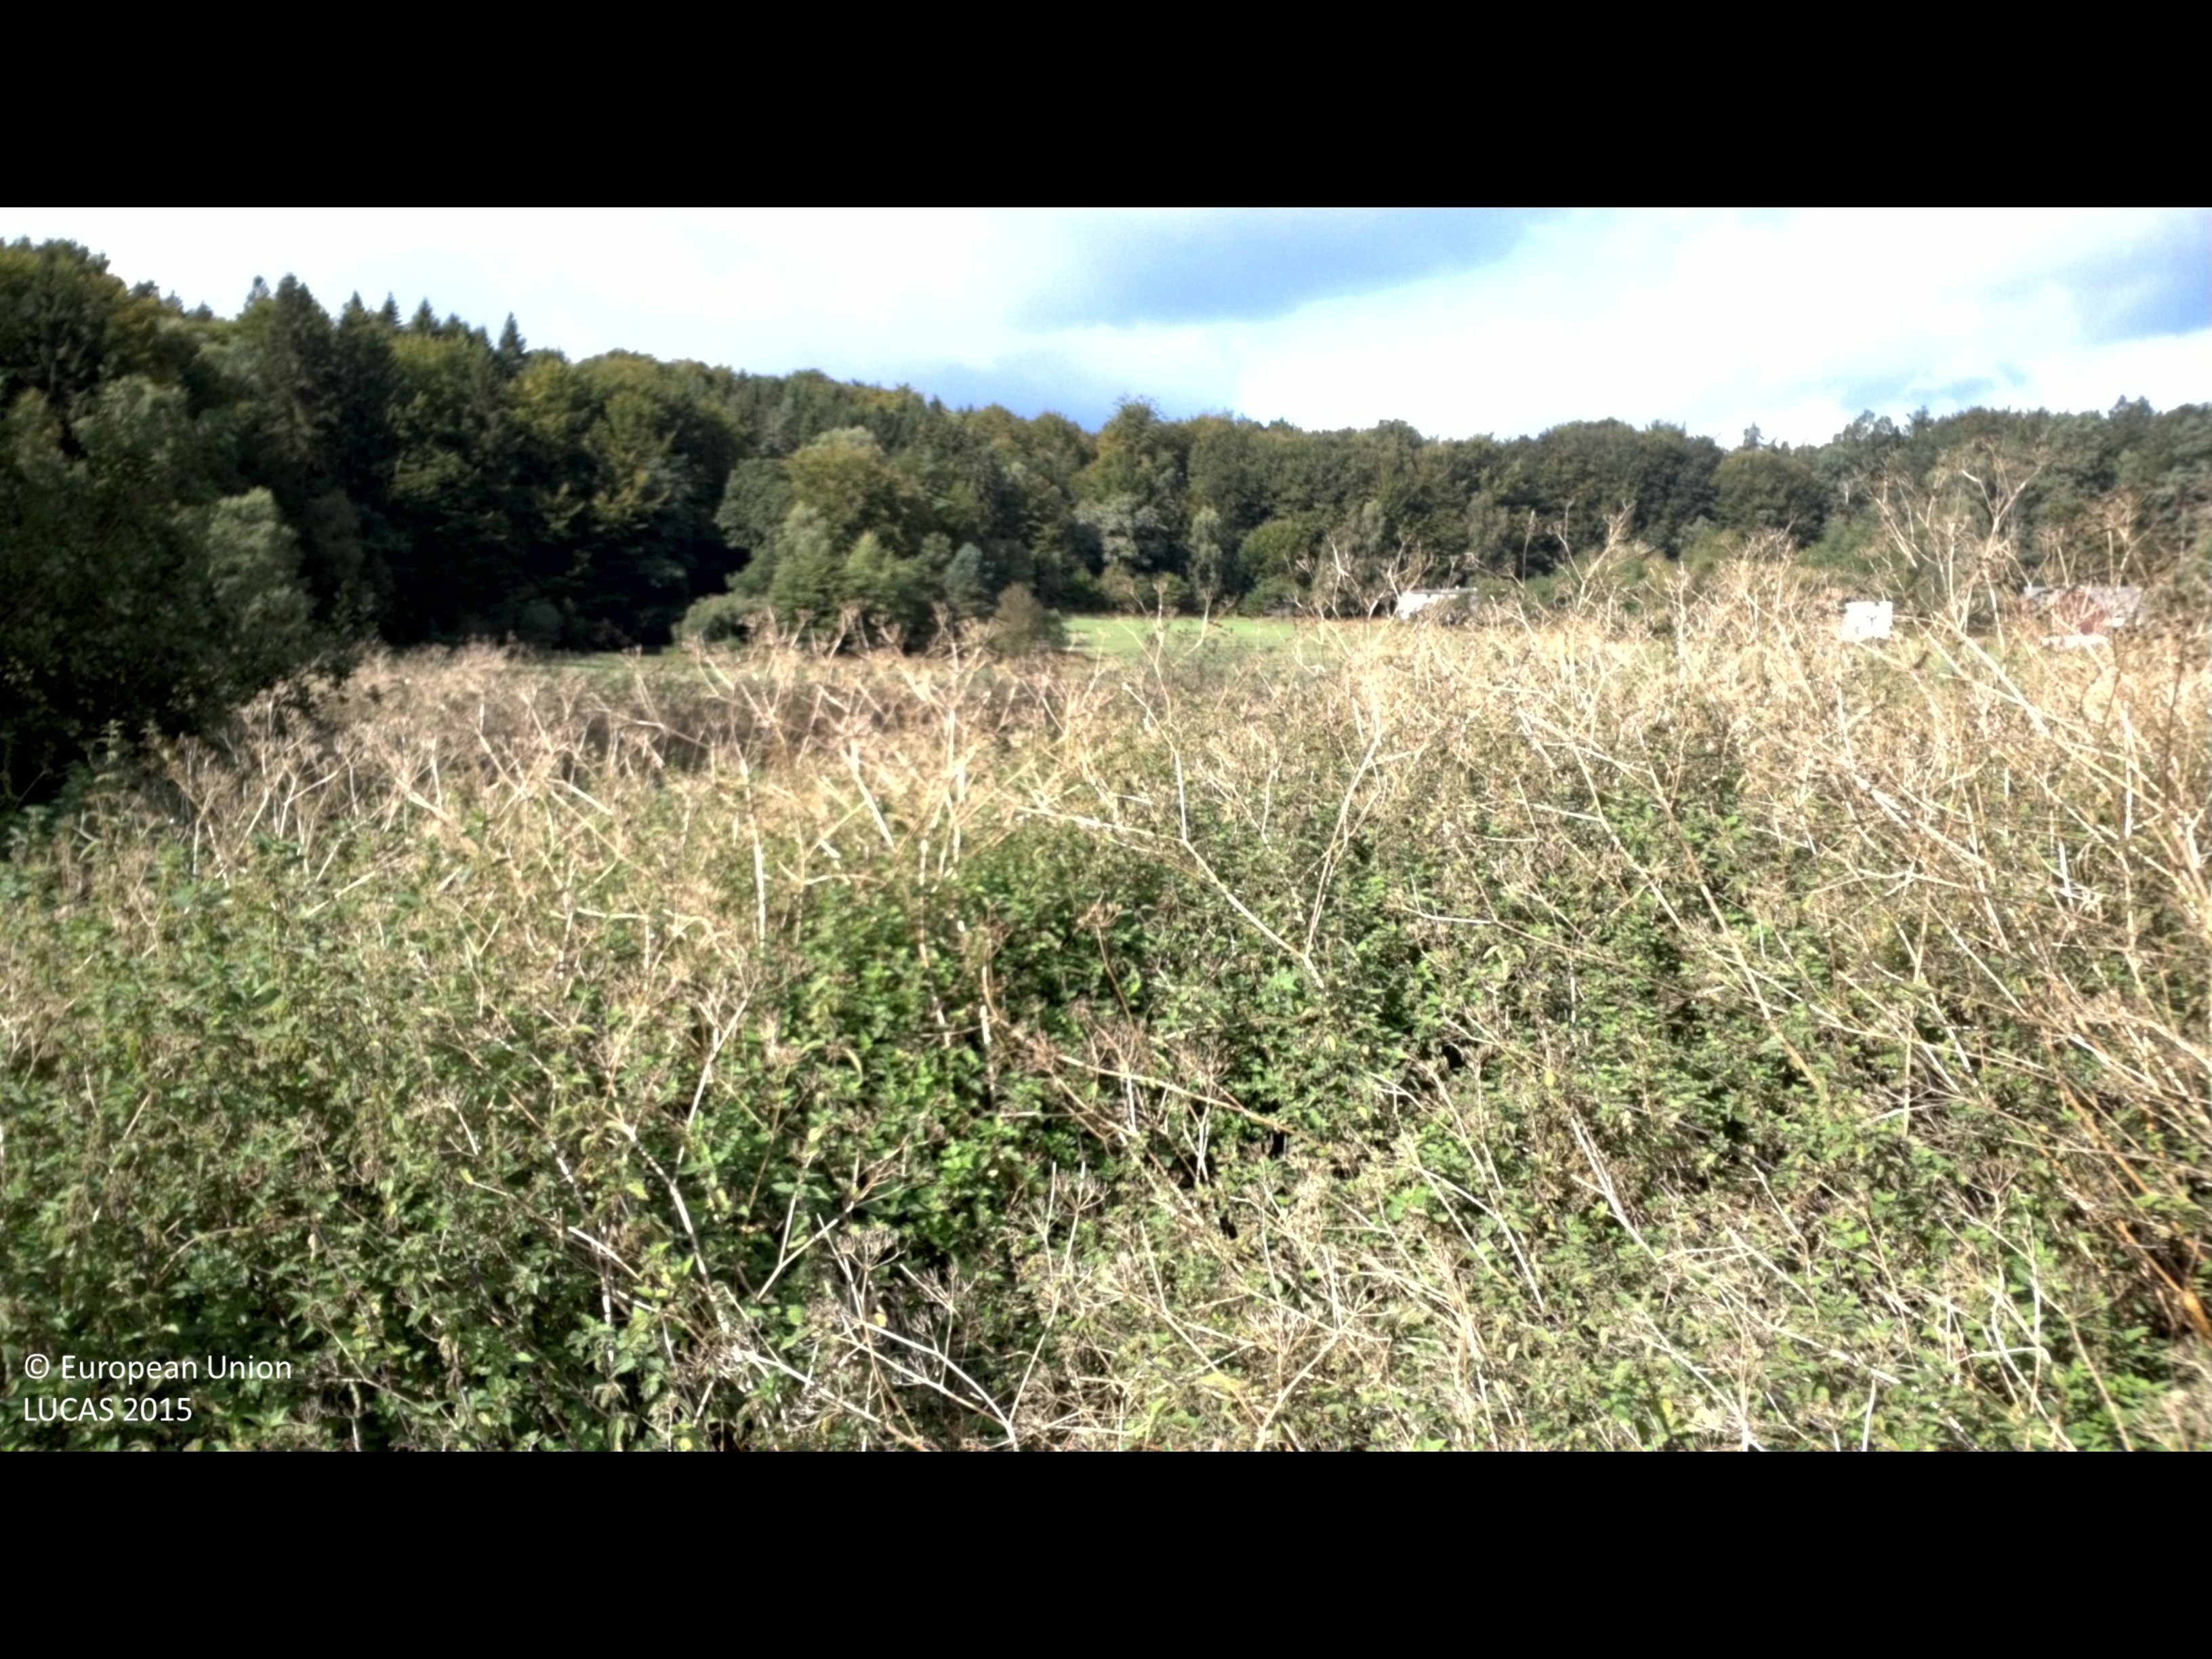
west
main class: Grassland
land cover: Spontaneously vegetated surfaces
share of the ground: > 75 %
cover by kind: herbaceous plants 100 %
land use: Fallow land
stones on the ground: < 10 %
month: September
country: SE
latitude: 56.1778
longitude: 14.5892
